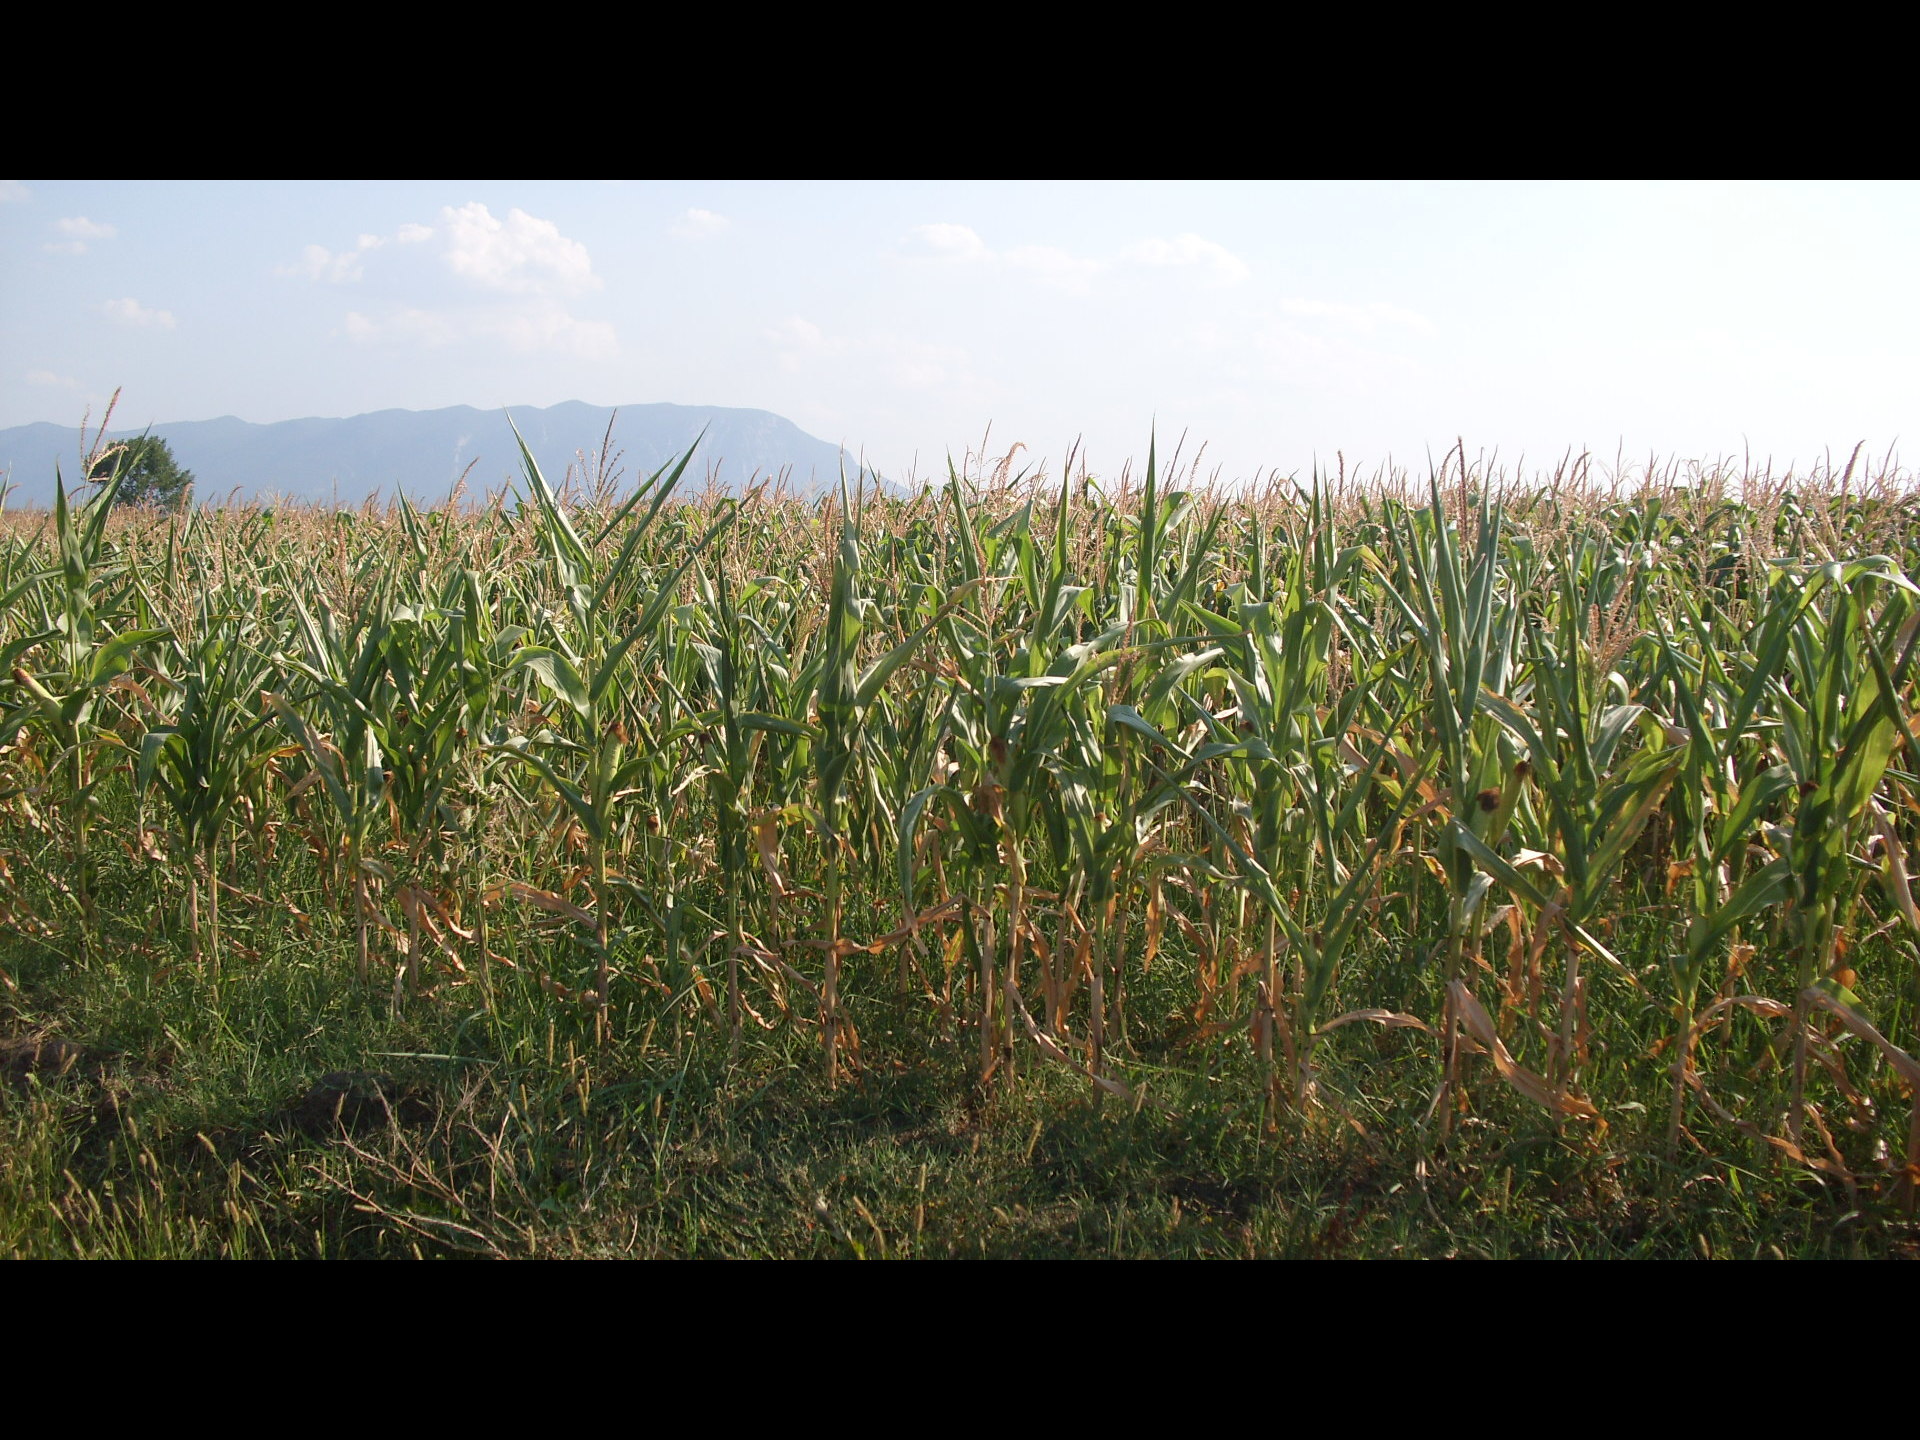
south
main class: Cropland
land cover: Sunflower
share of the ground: > 75 %
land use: Agriculture (excluding fallow land and kitchen gardens)
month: August
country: BG
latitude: 43.3633
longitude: 23.4308
